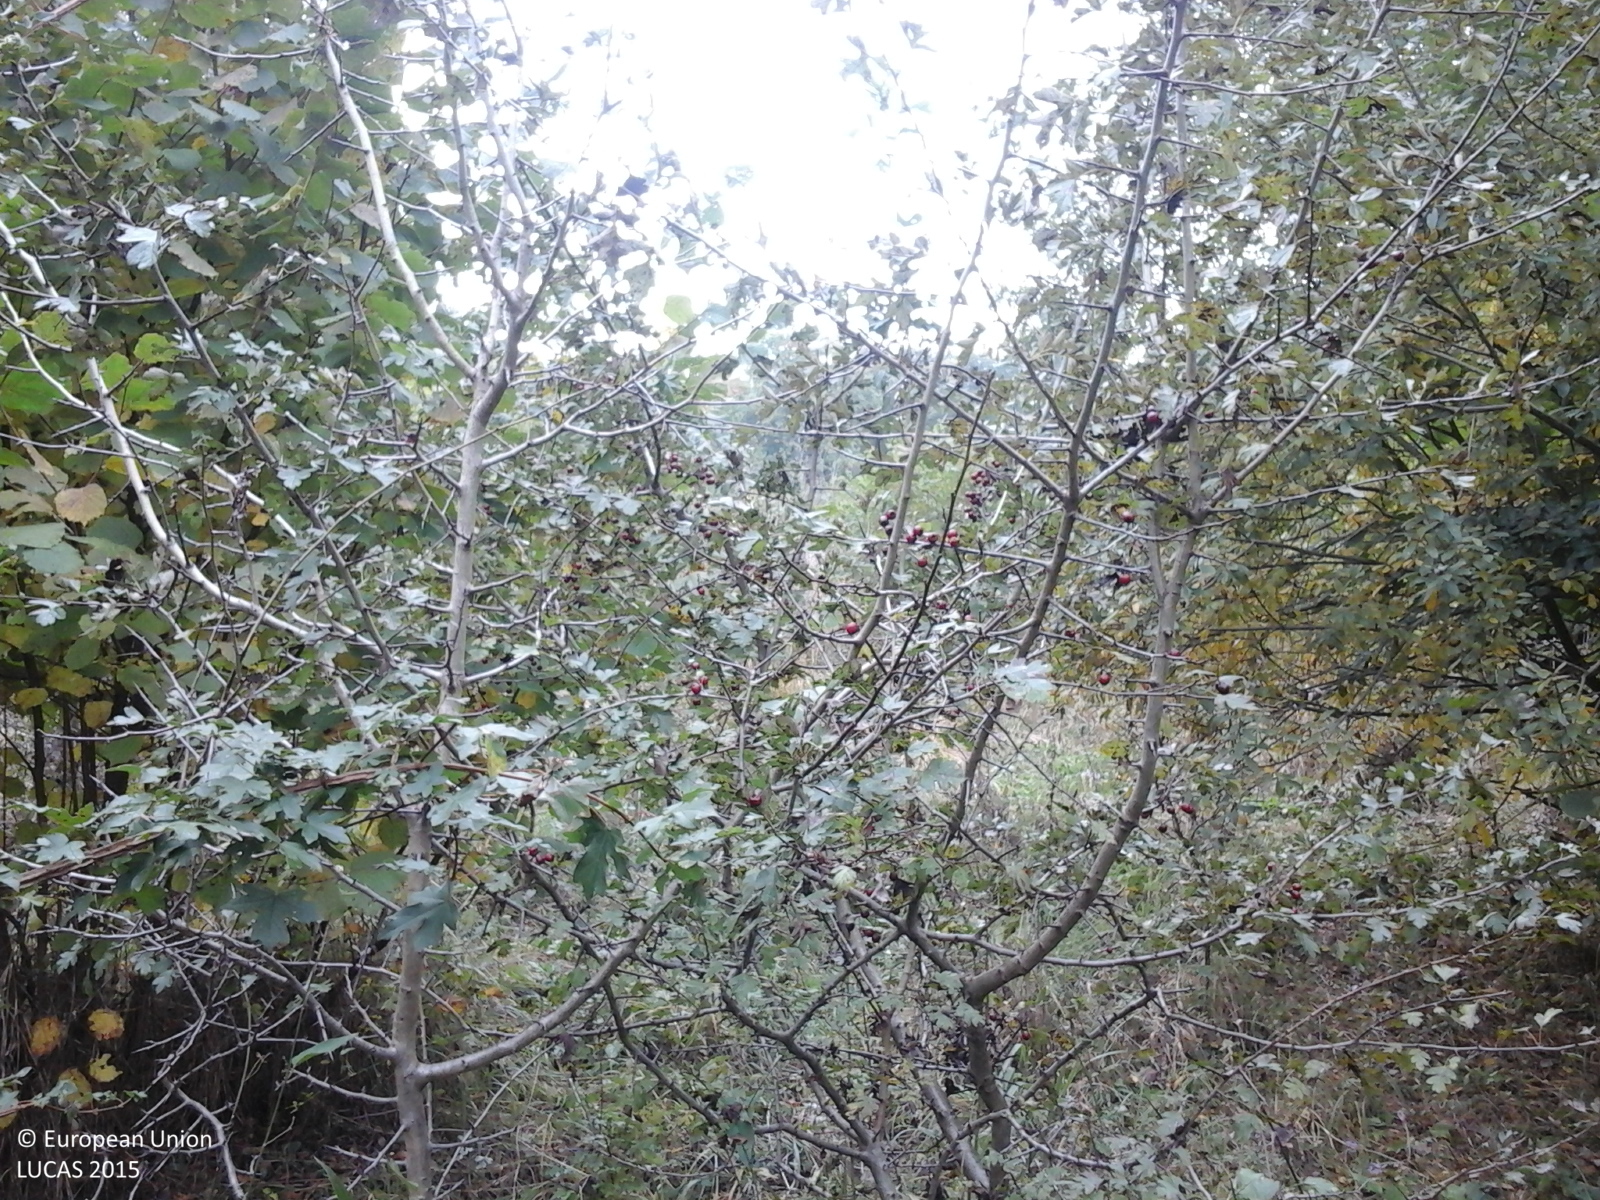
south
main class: Shrubland
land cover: Shrubland with sparse tree cover
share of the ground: > 75 %
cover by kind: shrubs 85 %, herbaceous plants 10 %, broadleaved forest trees 5 %
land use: Fallow land
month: October
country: RO
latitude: 46.2917
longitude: 24.8784
